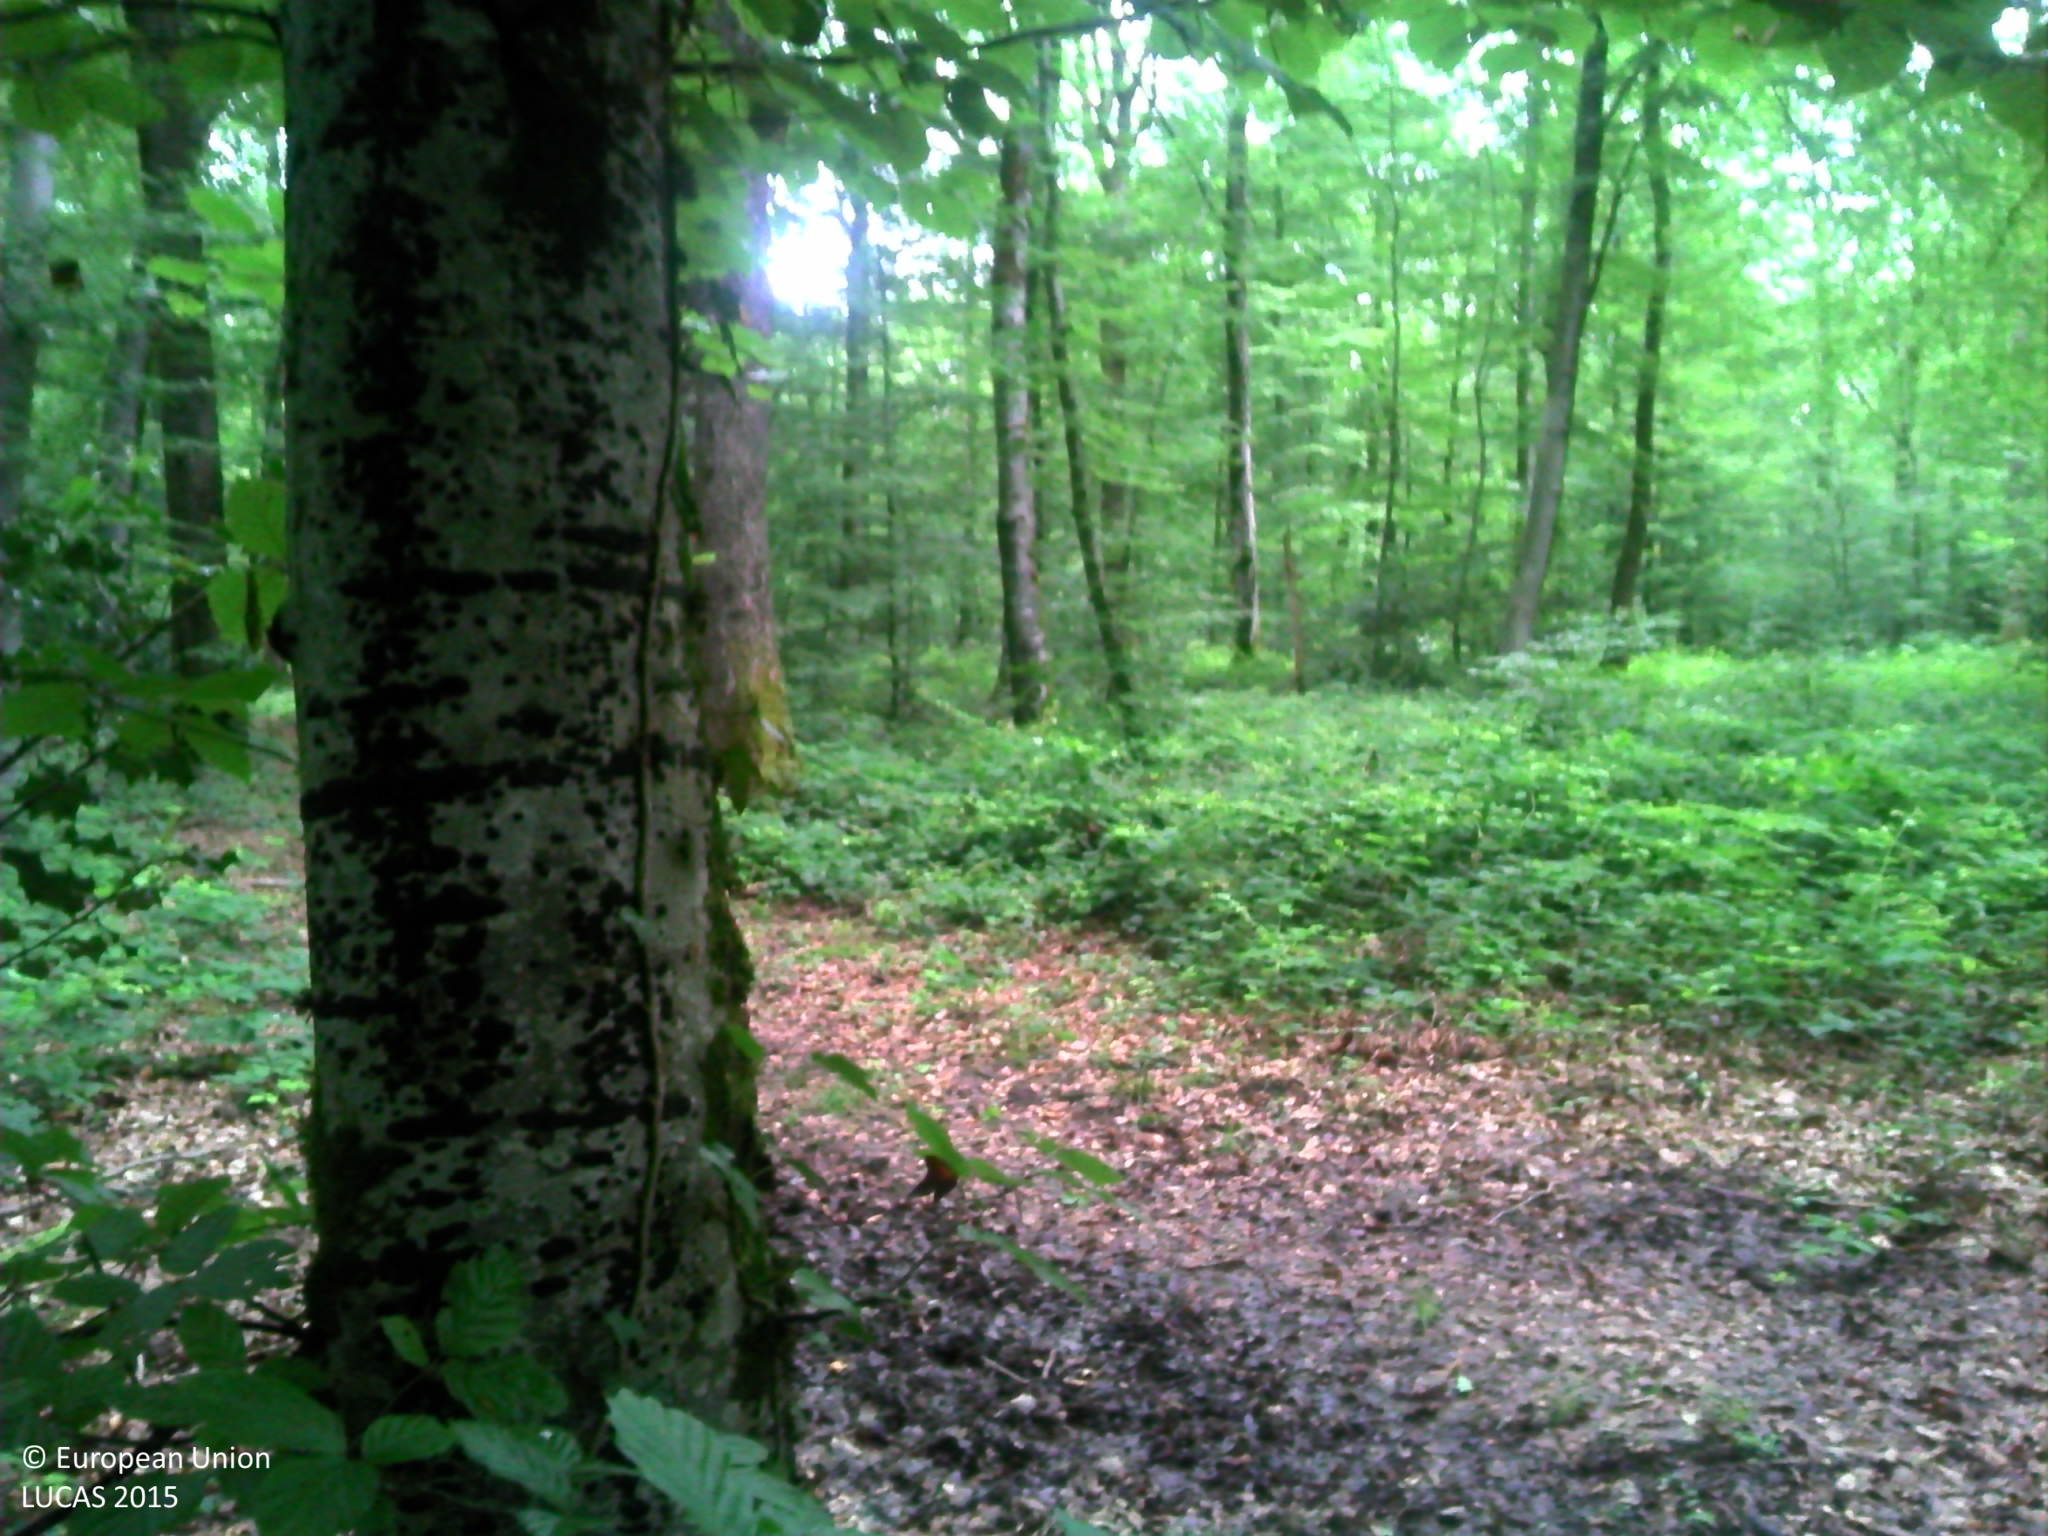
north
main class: Woodland
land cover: Broadleaved woodland
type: beech forest
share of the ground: > 75 %
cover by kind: broadleaved forest trees 90 %, shrubs 5 %, herbaceous plants 5 %
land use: Forestry
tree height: > 5 m
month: June
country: FR
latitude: 47.6943
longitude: 6.3371
